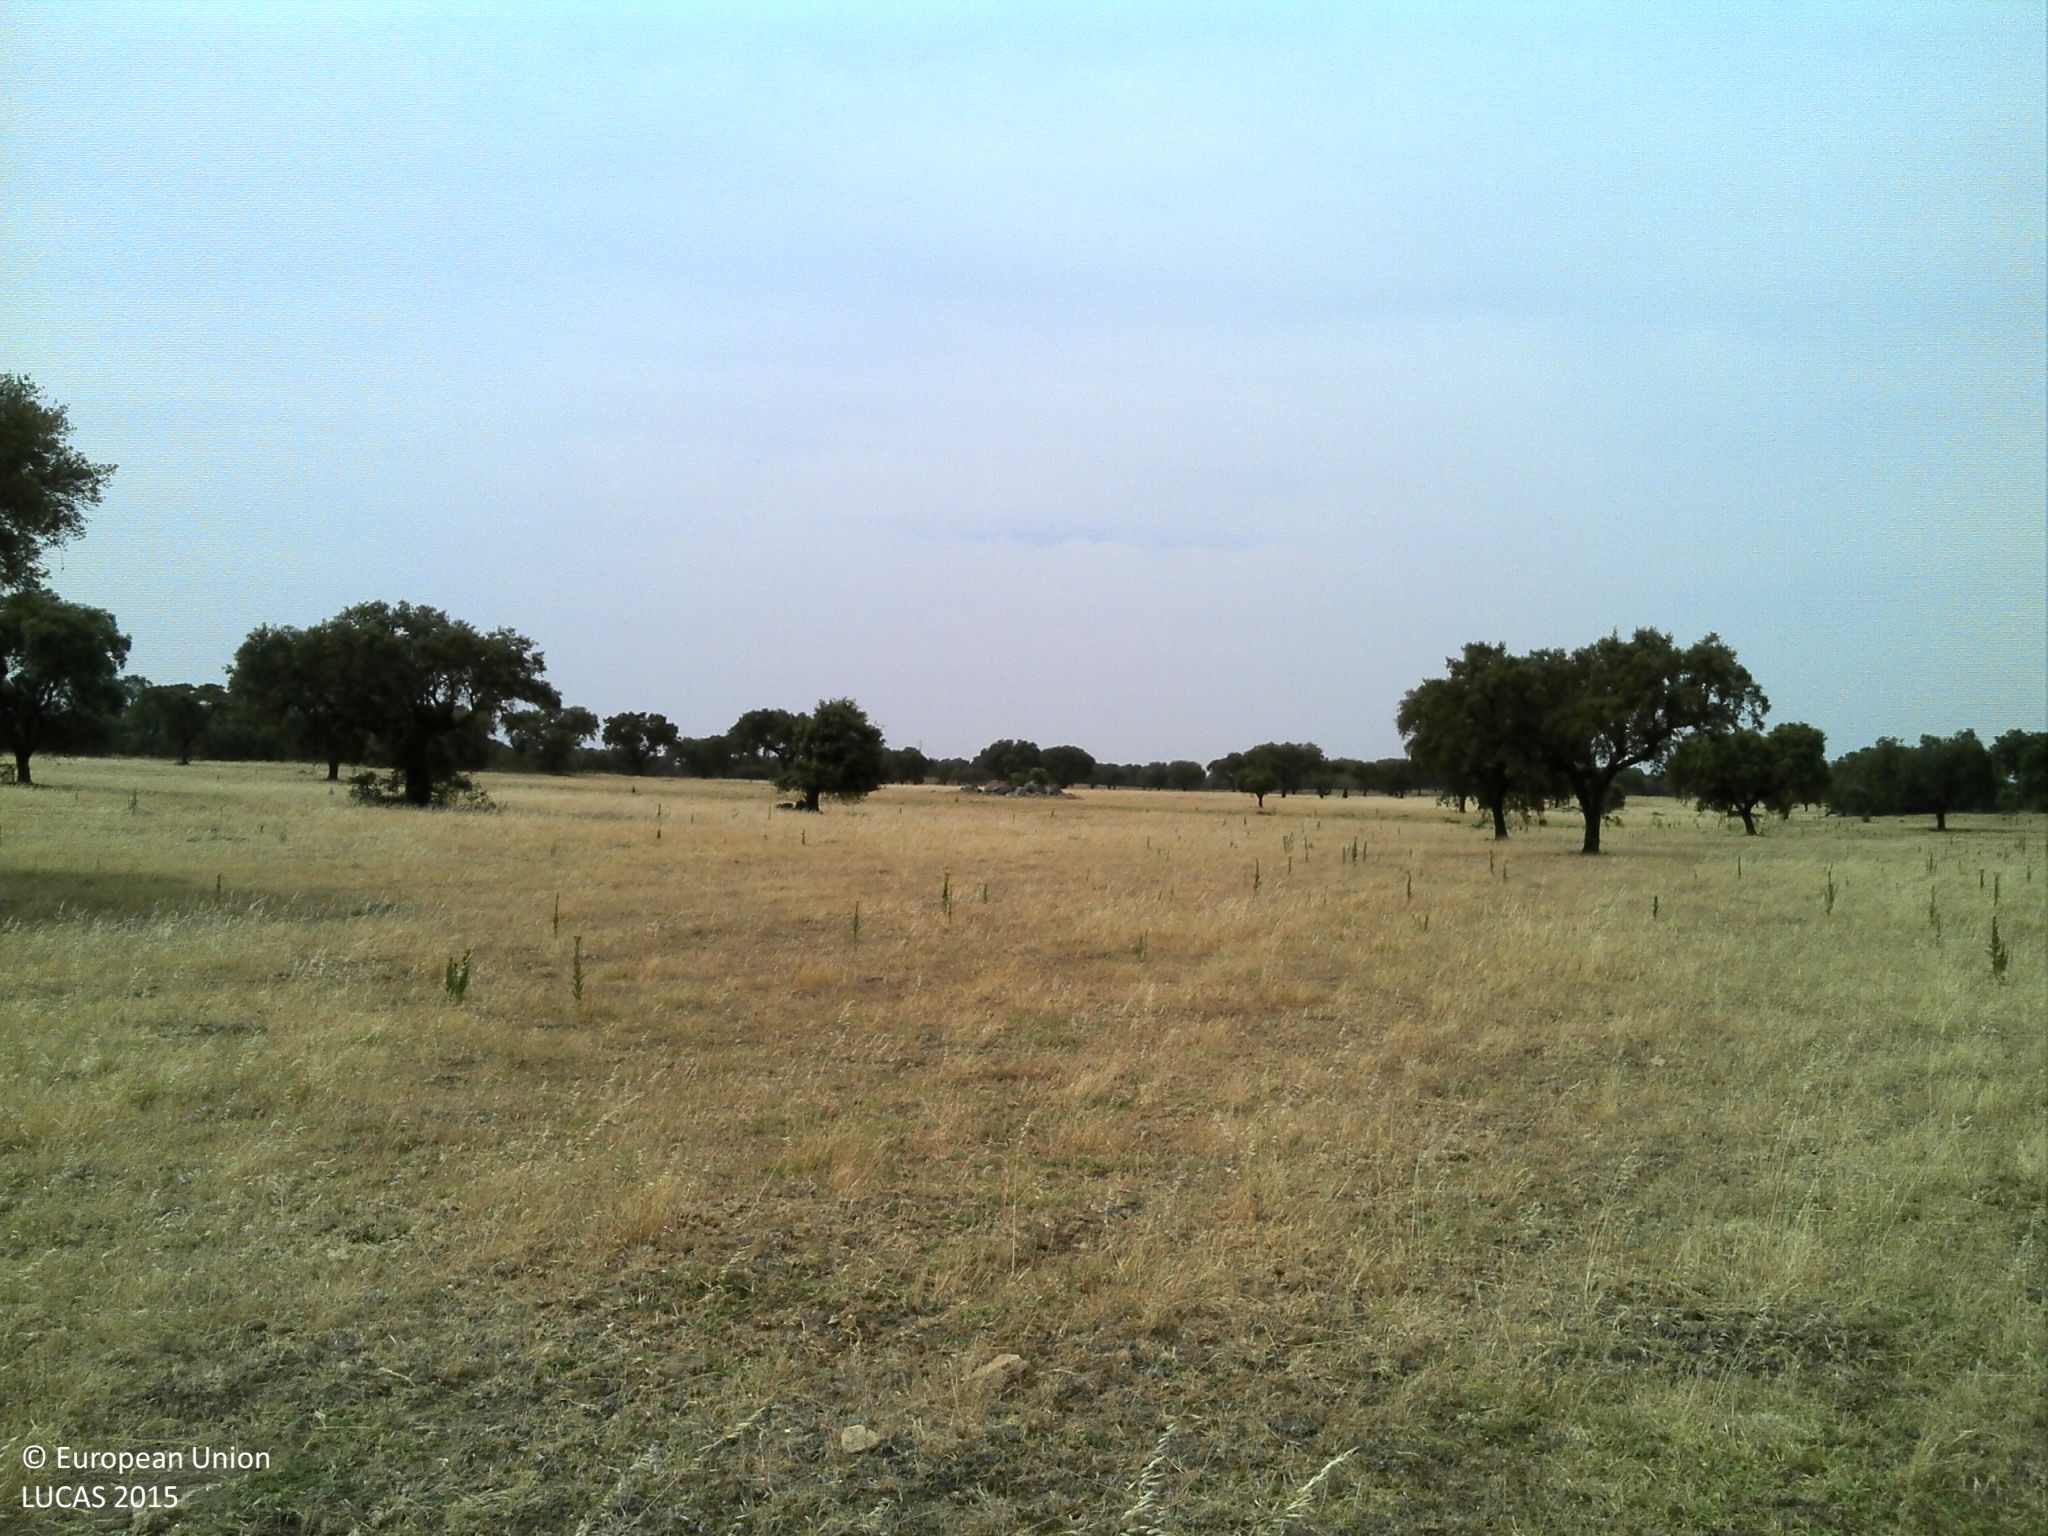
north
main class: Grassland
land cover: Grassland without tree/shrub cover
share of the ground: 25 - 50 %
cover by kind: unconsolidated bare surface 65 %, herbaceous plants 35 %
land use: Agriculture (excluding fallow land and kitchen gardens)
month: June
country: PT
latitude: 38.4216
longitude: -7.7991
